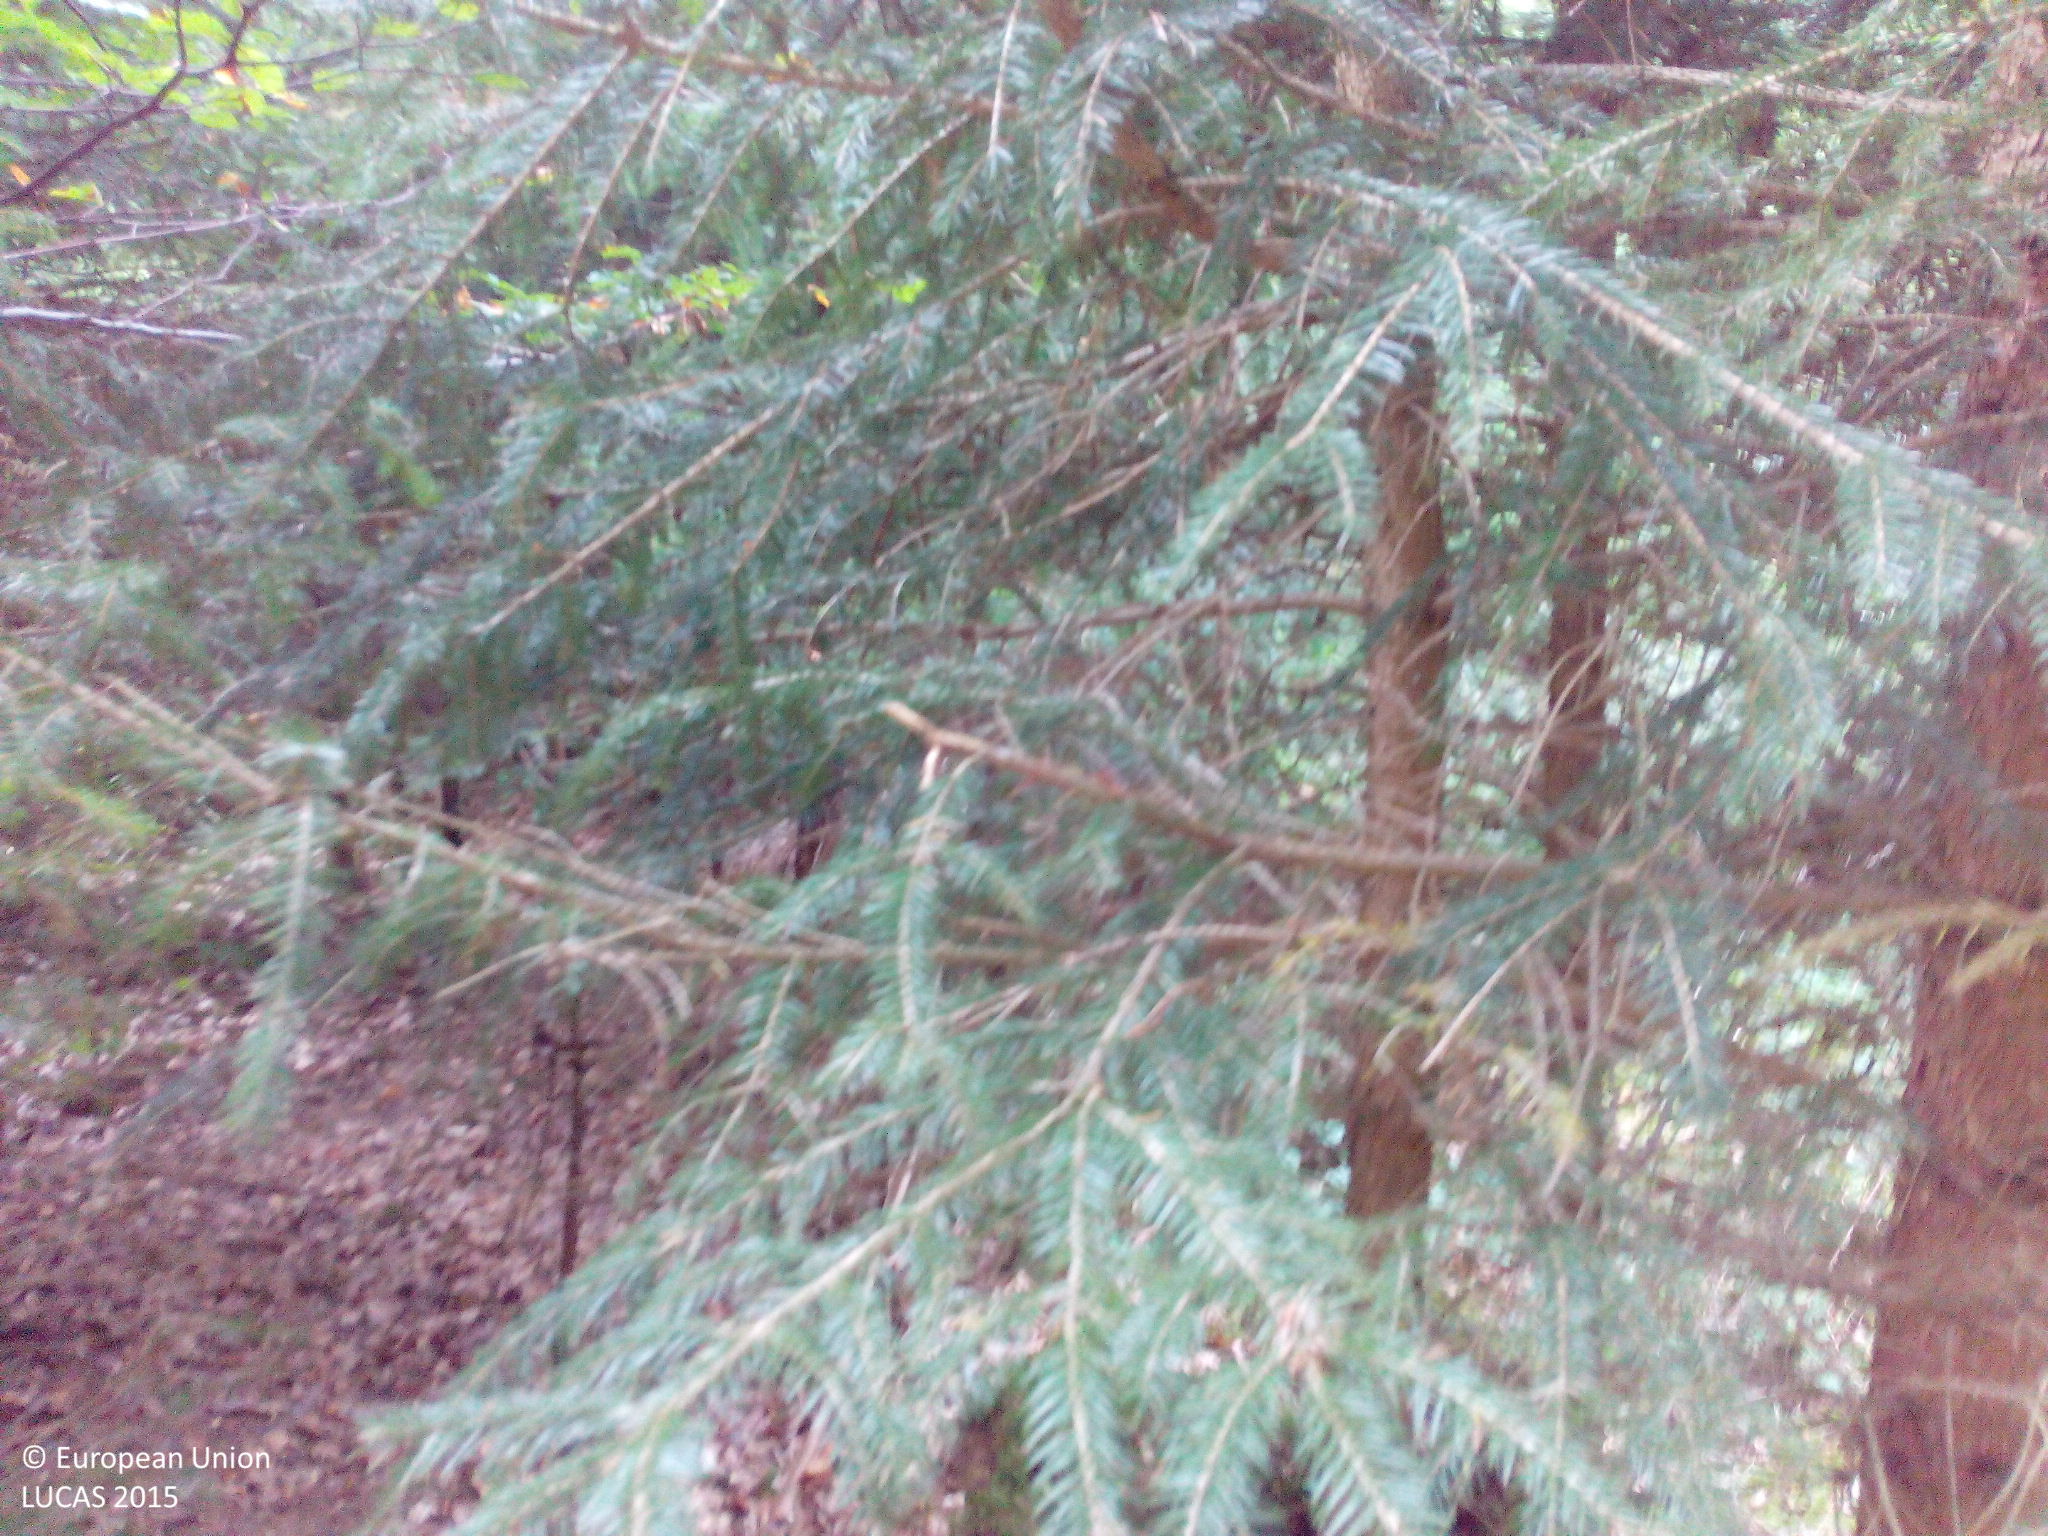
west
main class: Woodland
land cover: Spruce dominated coniferous woodland
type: hemiboreal forest and nemoral coniferous forest and mixed broadleaved-coniferous forest
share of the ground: > 75 %
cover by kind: coniferous forest trees 100 %
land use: Forestry
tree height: > 5 m
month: September
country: DE
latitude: 48.4836
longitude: 11.4740
